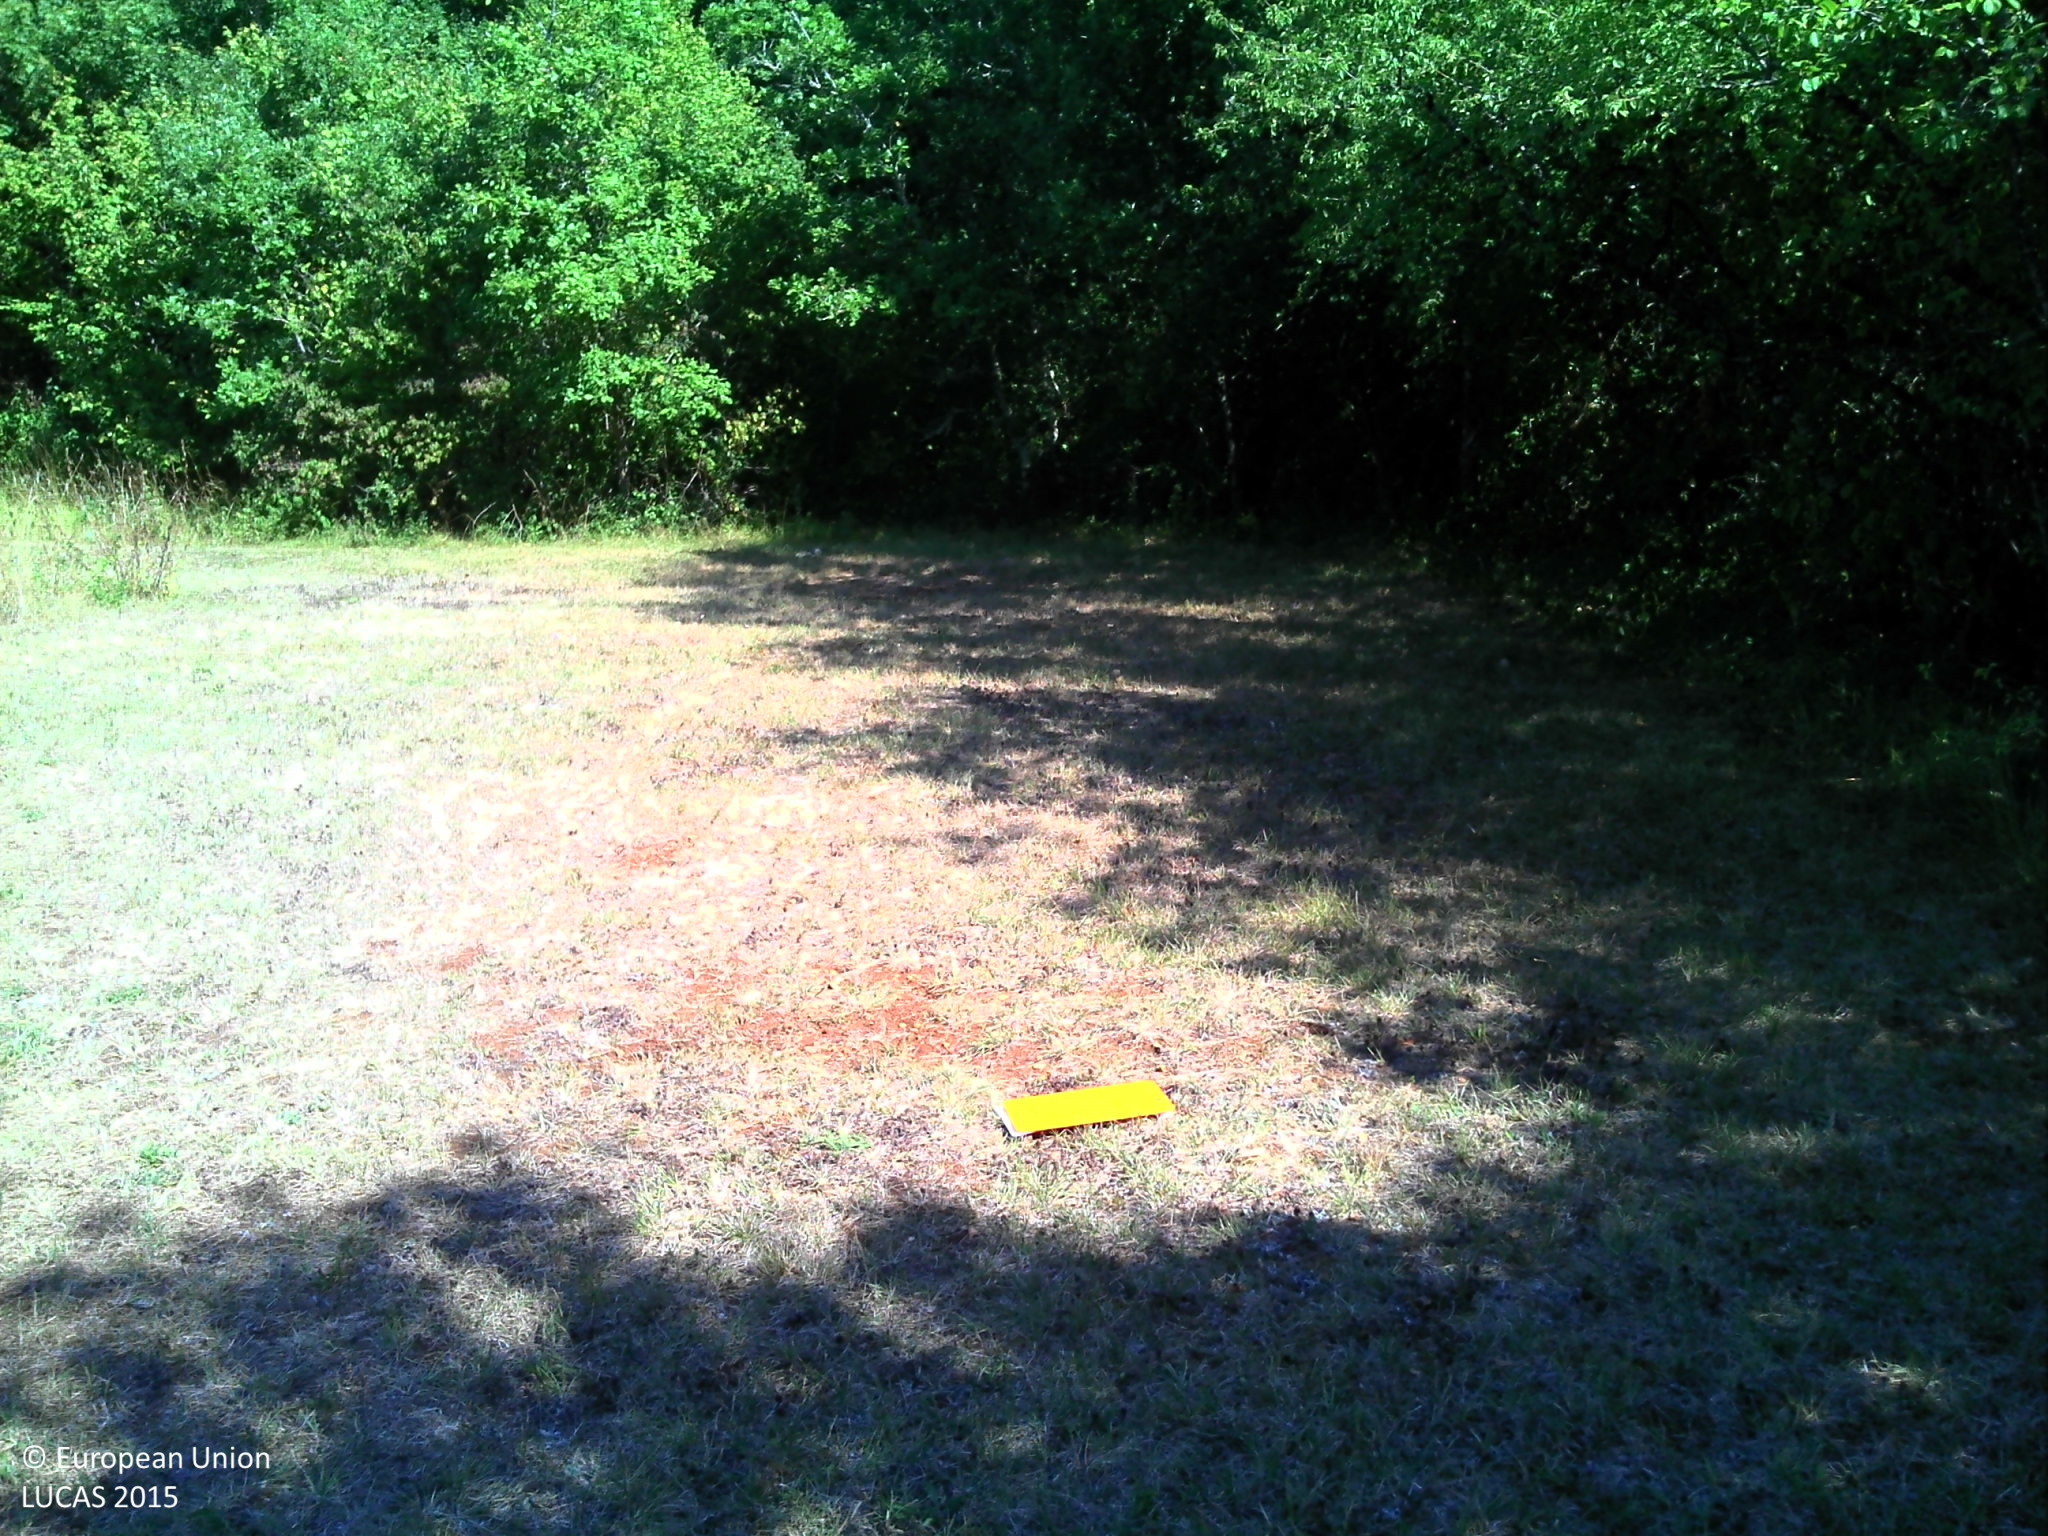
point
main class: Grassland
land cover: Grassland without tree/shrub cover
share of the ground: > 75 %
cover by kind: herbaceous plants 90 %, lichens and mosses 10 %
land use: Residential
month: August
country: FR
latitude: 44.7761
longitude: 0.8059
